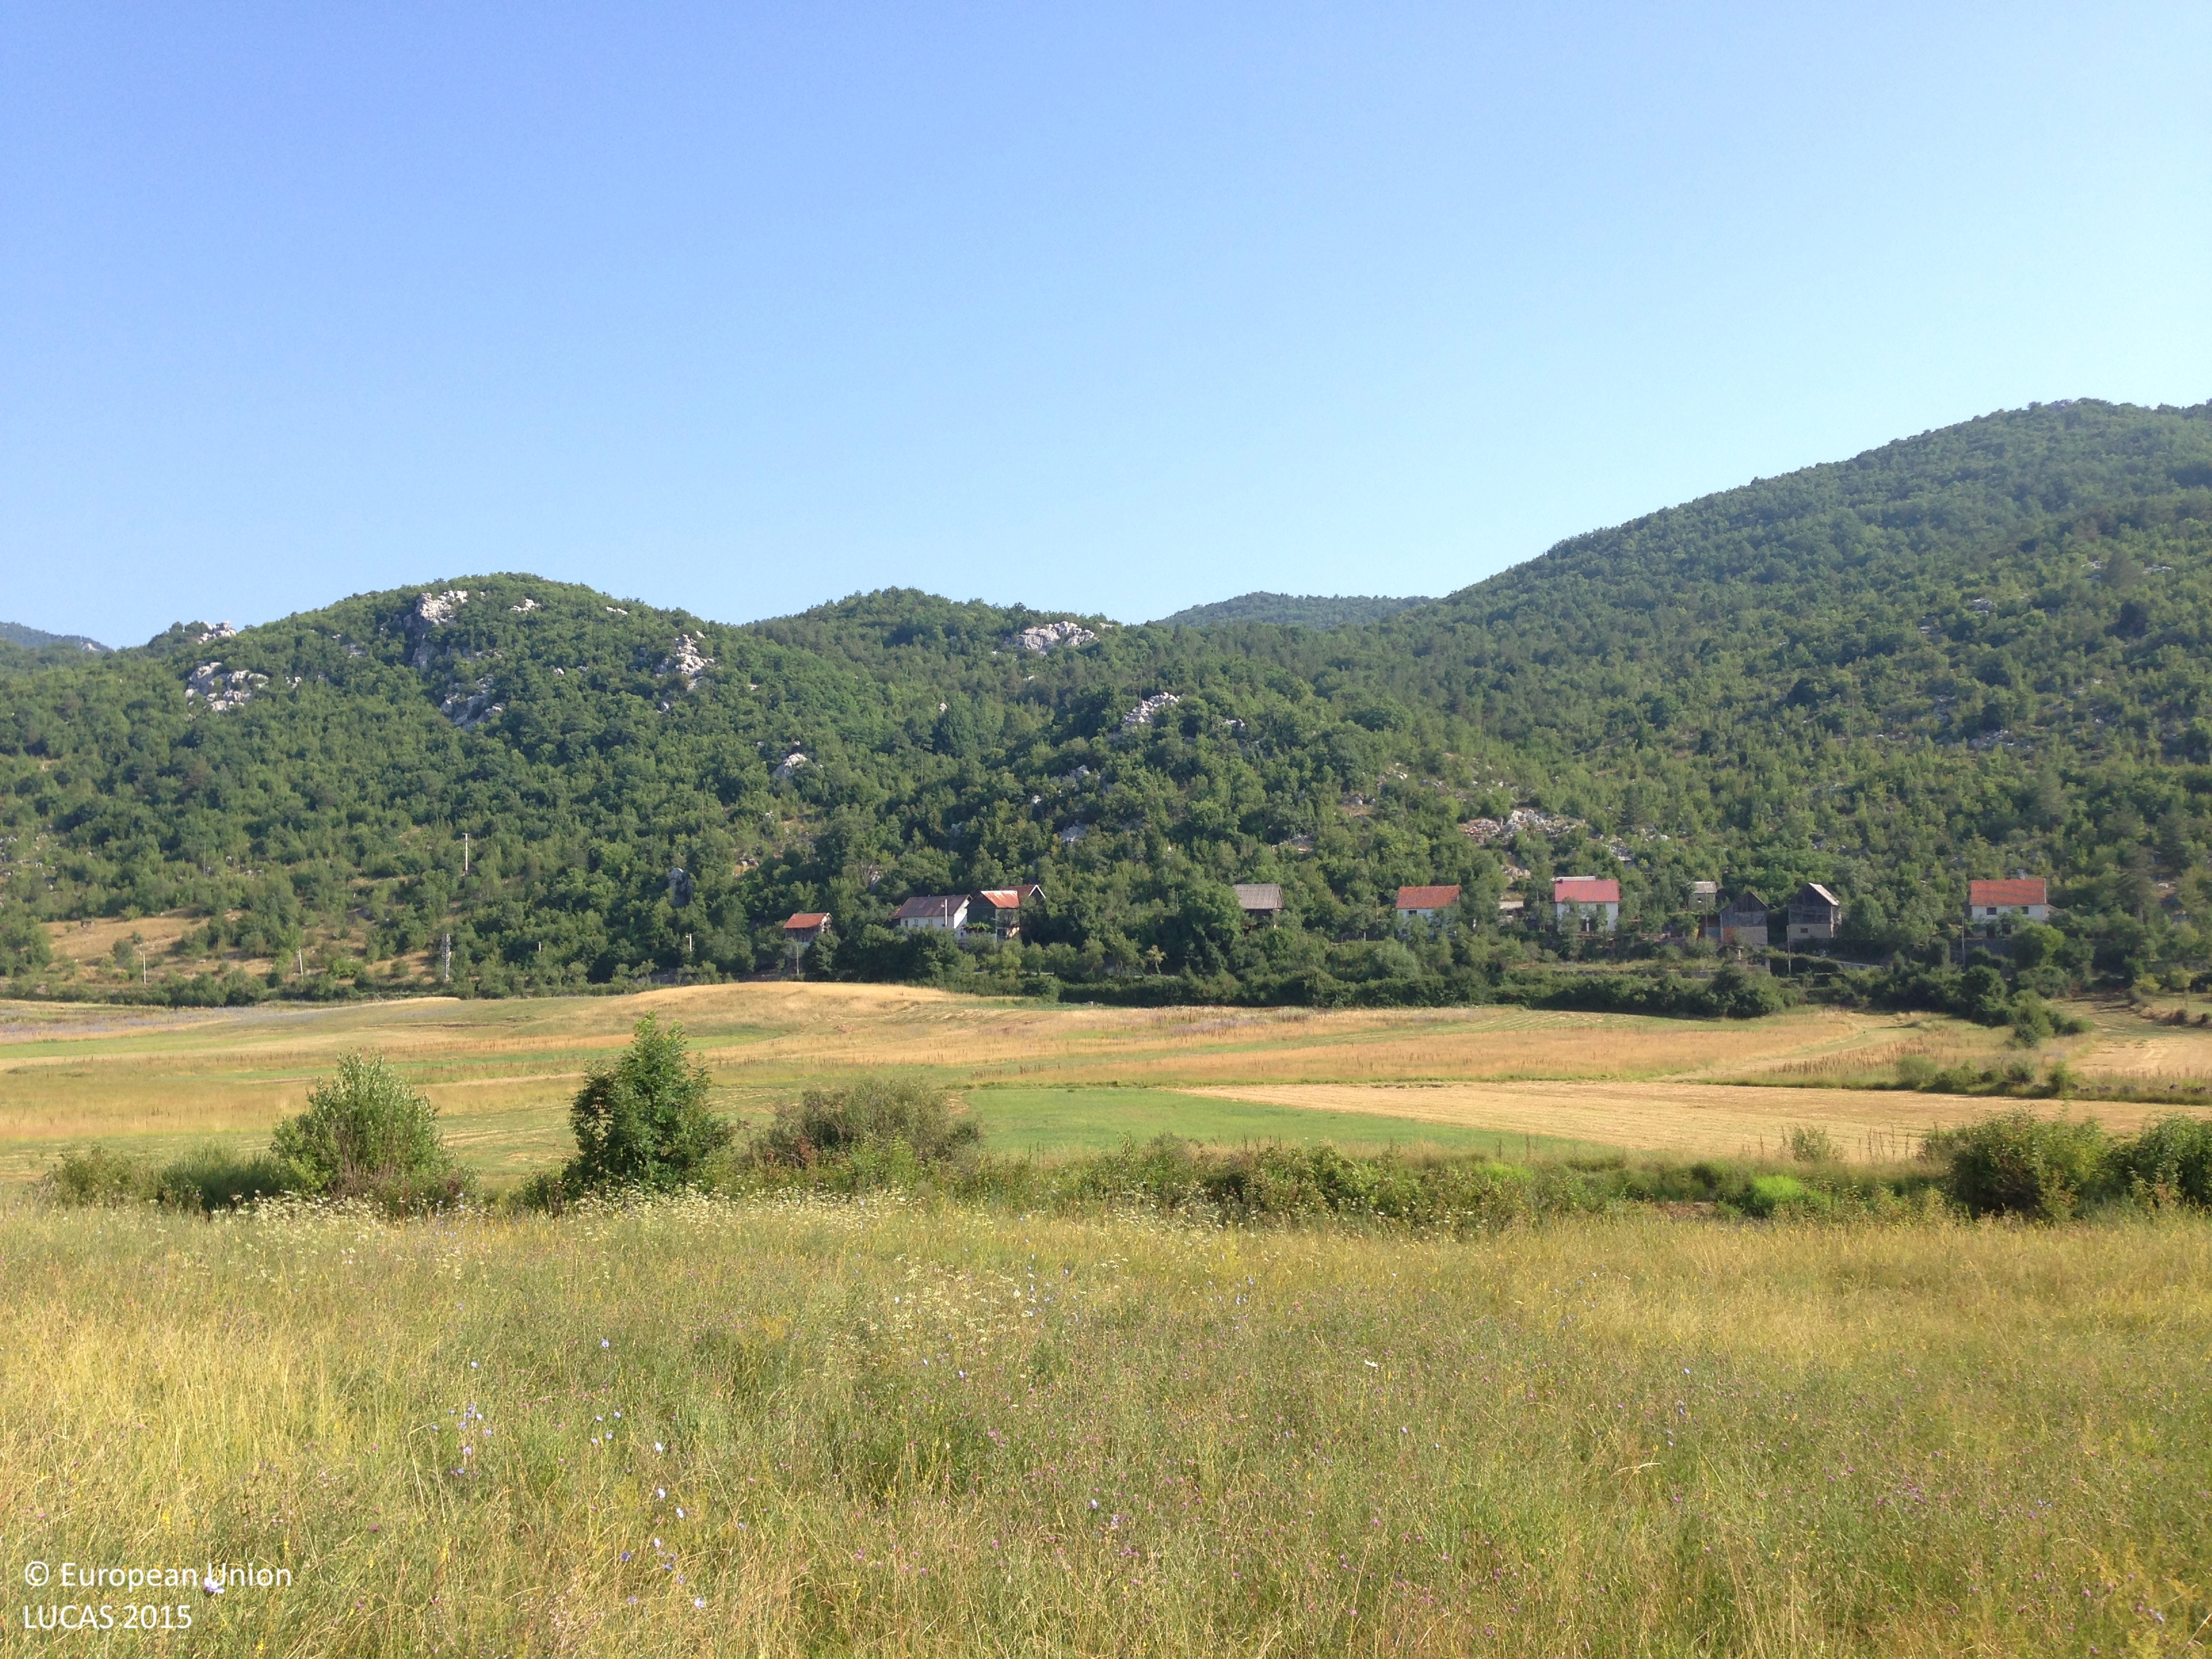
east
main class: Grassland
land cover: Grassland without tree/shrub cover
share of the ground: > 75 %
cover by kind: herbaceous plants 95 %, shrubs 5 %
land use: Agriculture (excluding fallow land and kitchen gardens)
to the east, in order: Grassland without tree/shrub cover; Shrubland with sparse tree cover; Grassland with sparse tree/shrub cover; Shrubland with sparse tree cover; Tracks; Grassland without tree/shrub cover; Electric lines; Grassland without tree/shrub cover
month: July
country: HR
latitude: 44.7604
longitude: 15.2367
